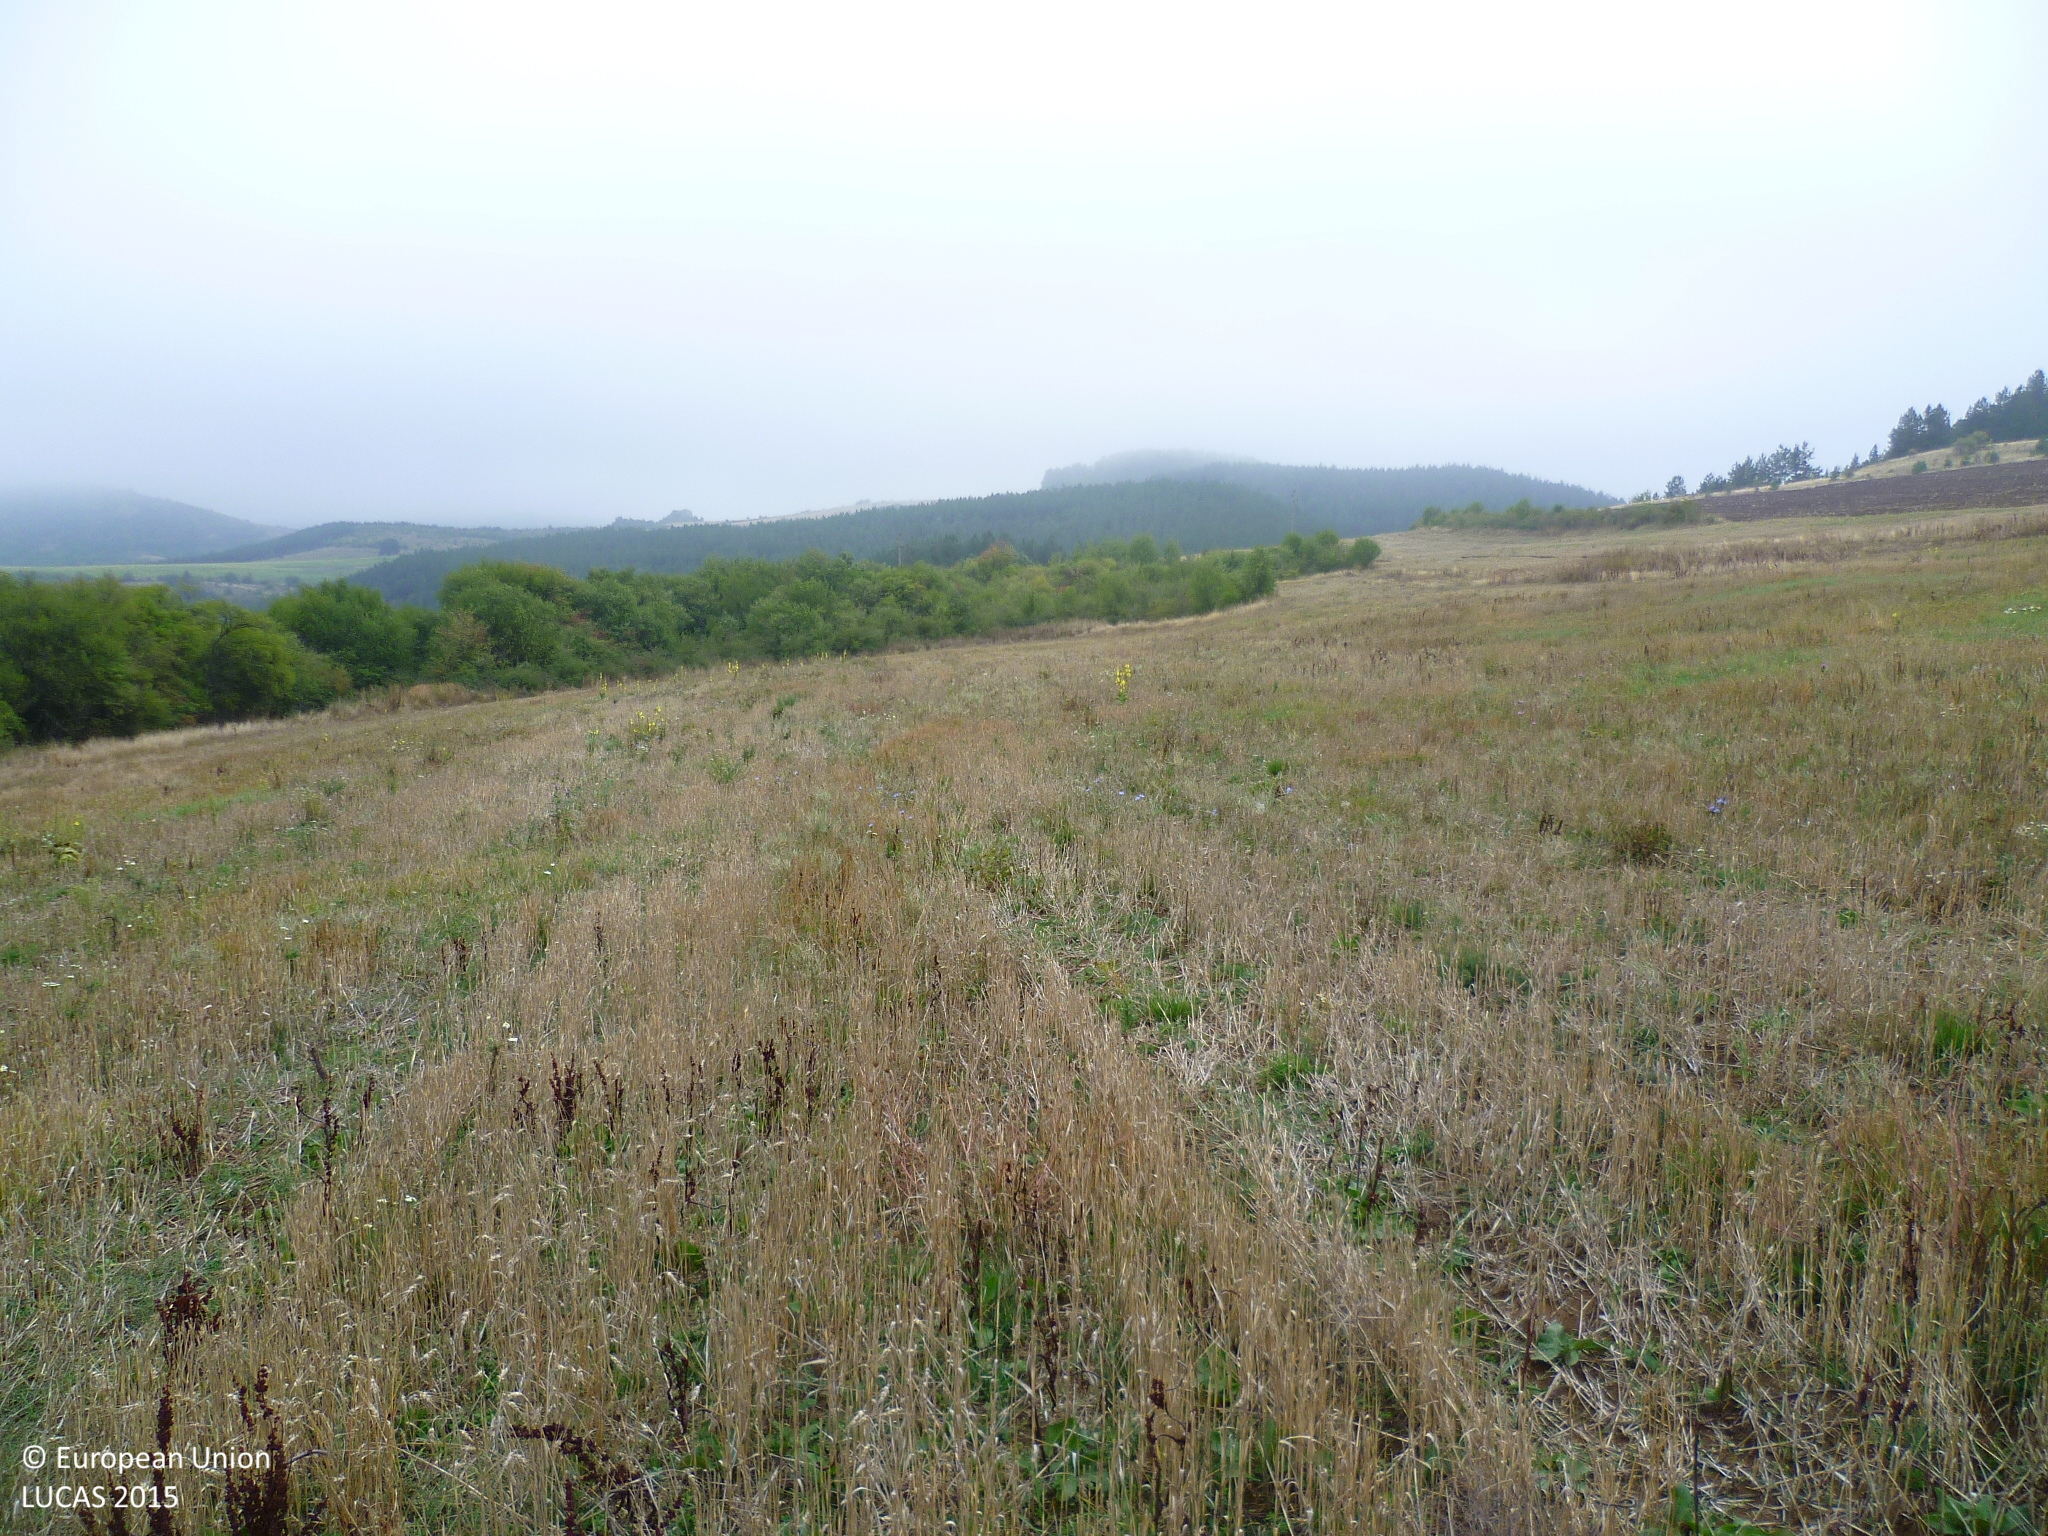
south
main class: Cropland
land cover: Barley
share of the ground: > 75 %
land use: Agriculture (excluding fallow land and kitchen gardens)
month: September
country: BG
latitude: 42.8013
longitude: 22.9793
